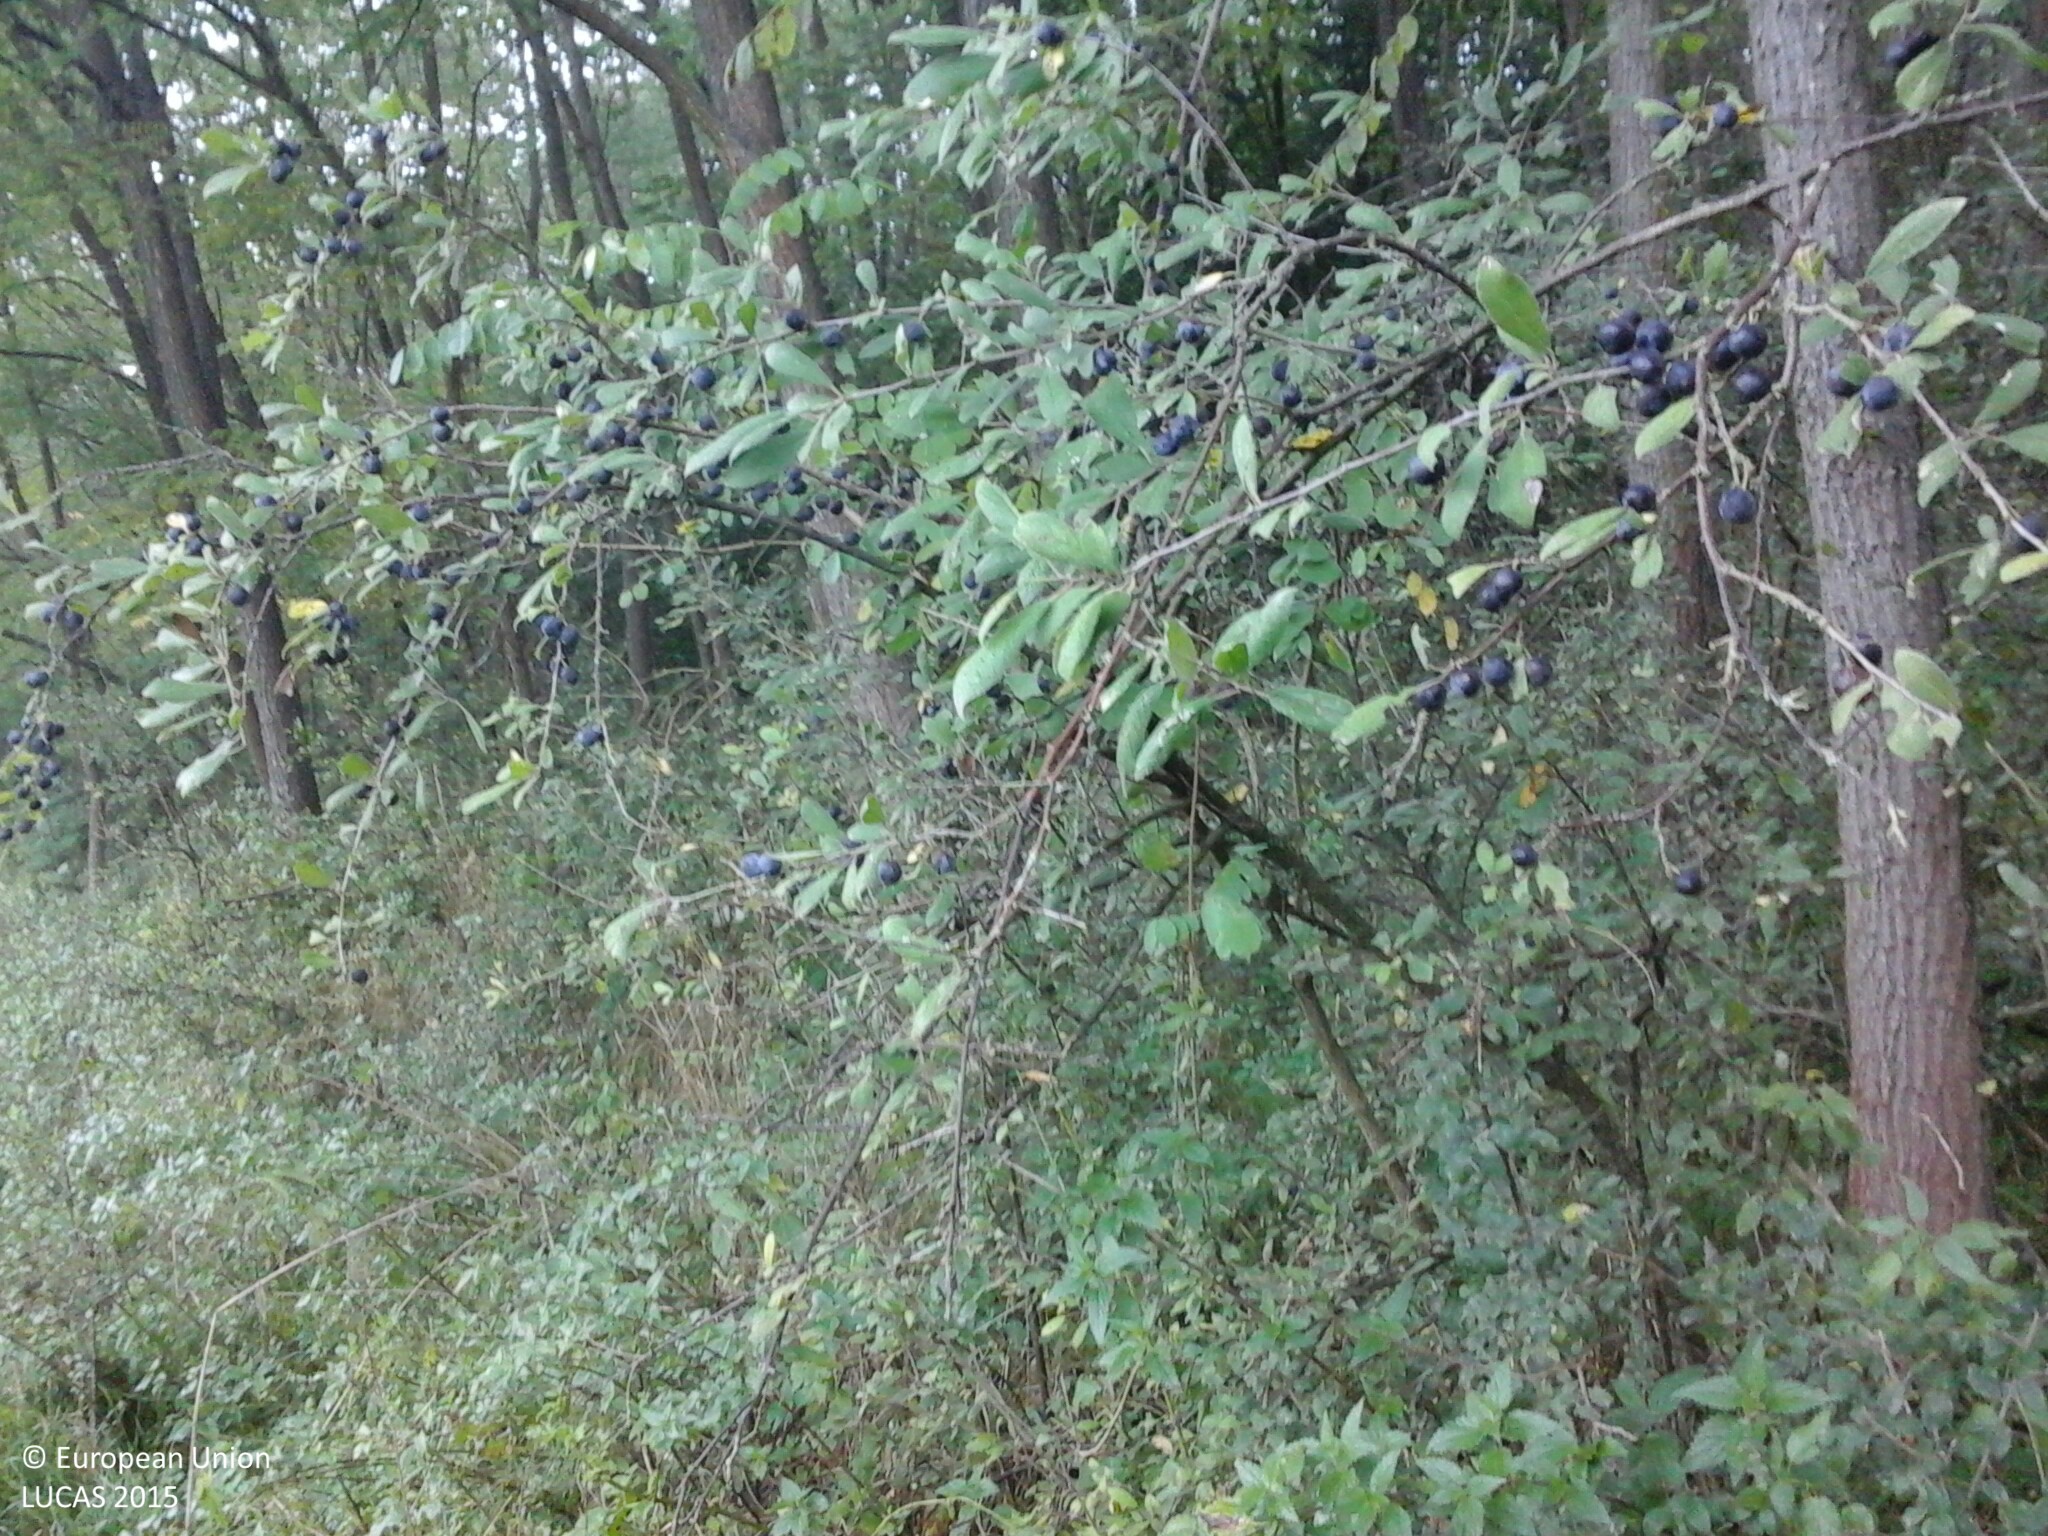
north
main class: Woodland
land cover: Broadleaved woodland
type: mesophytic deciduous forest
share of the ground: > 75 %
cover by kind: broadleaved forest trees 90 %, herbaceous plants 10 %
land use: Forestry
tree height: > 5 m
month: September
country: HU
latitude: 48.1422
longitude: 20.0684
